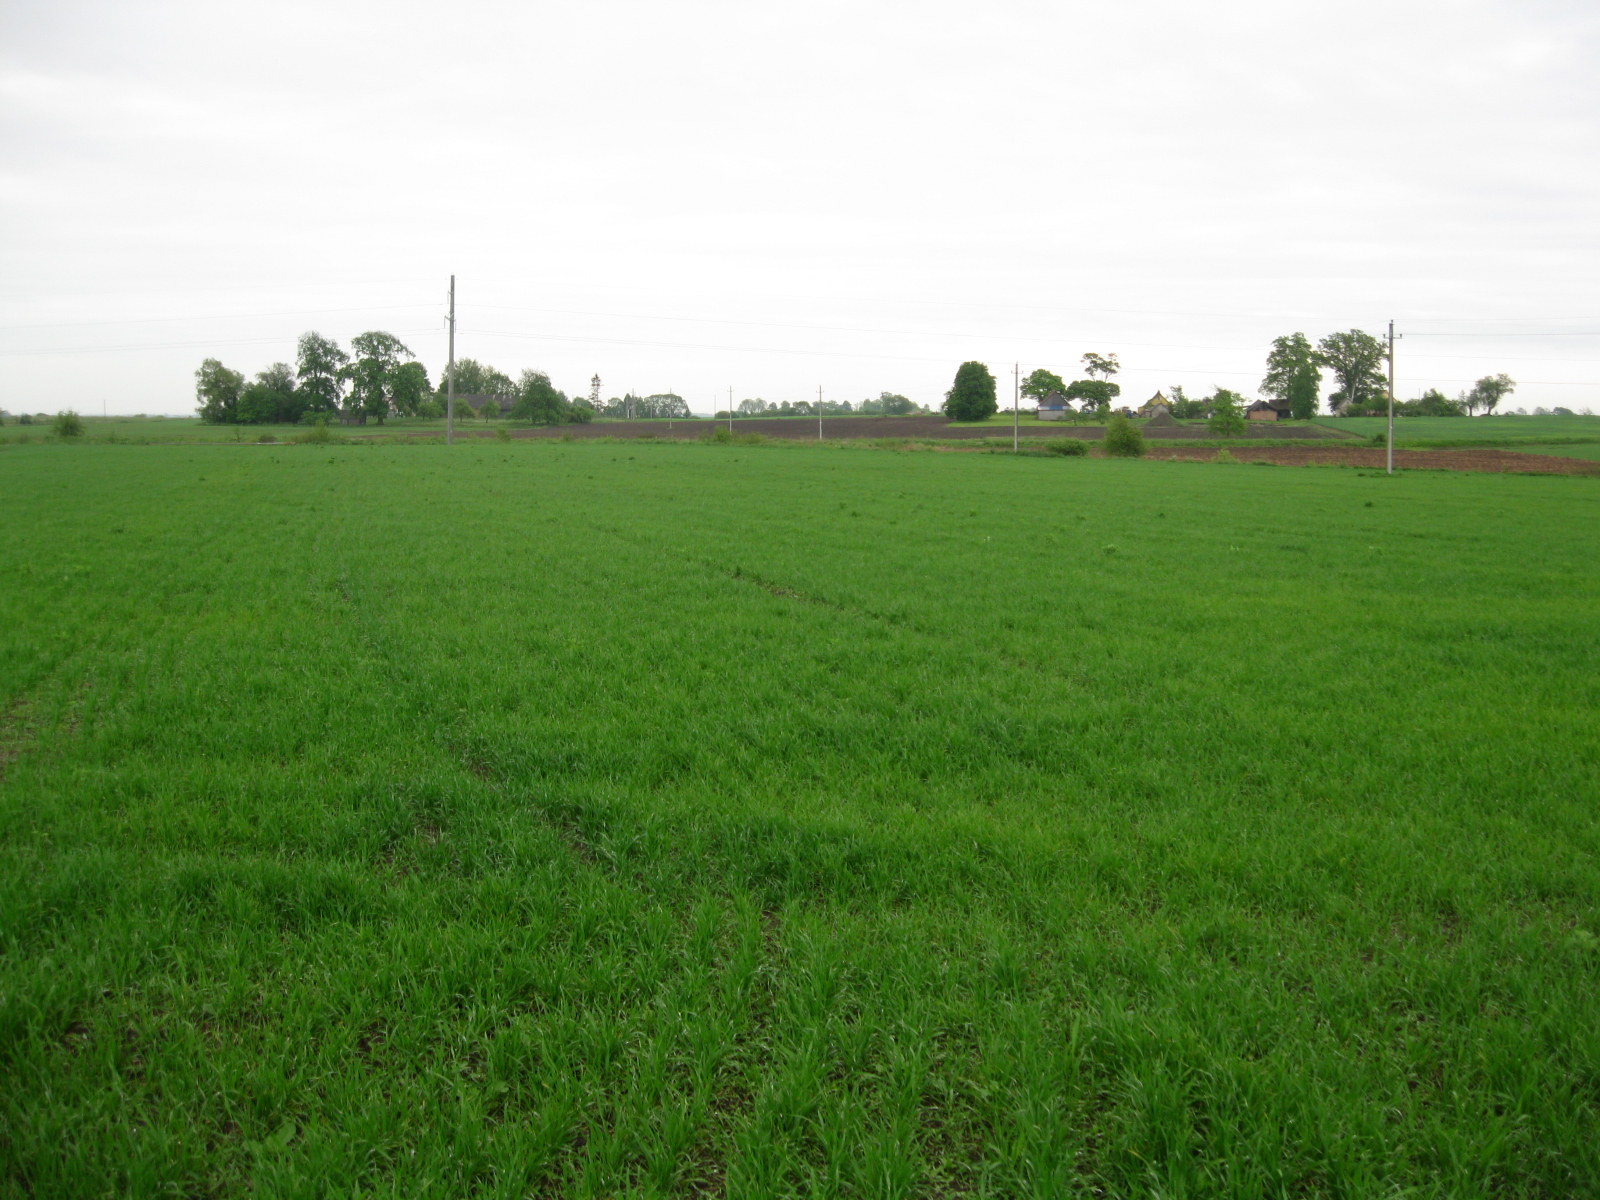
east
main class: Cropland
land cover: Common wheat
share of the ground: > 75 %
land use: Agriculture (excluding fallow land and kitchen gardens)
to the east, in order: Common wheat; Electric lines; Common wheat; Grassland with sparse tree/shrub cover; Inland fresh running water; Spontaneously vegetated surfaces; Paved roads, cycling and walking lanes; Spontaneously vegetated surfaces; Common wheat
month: May
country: LT
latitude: 55.9062
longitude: 24.3475
